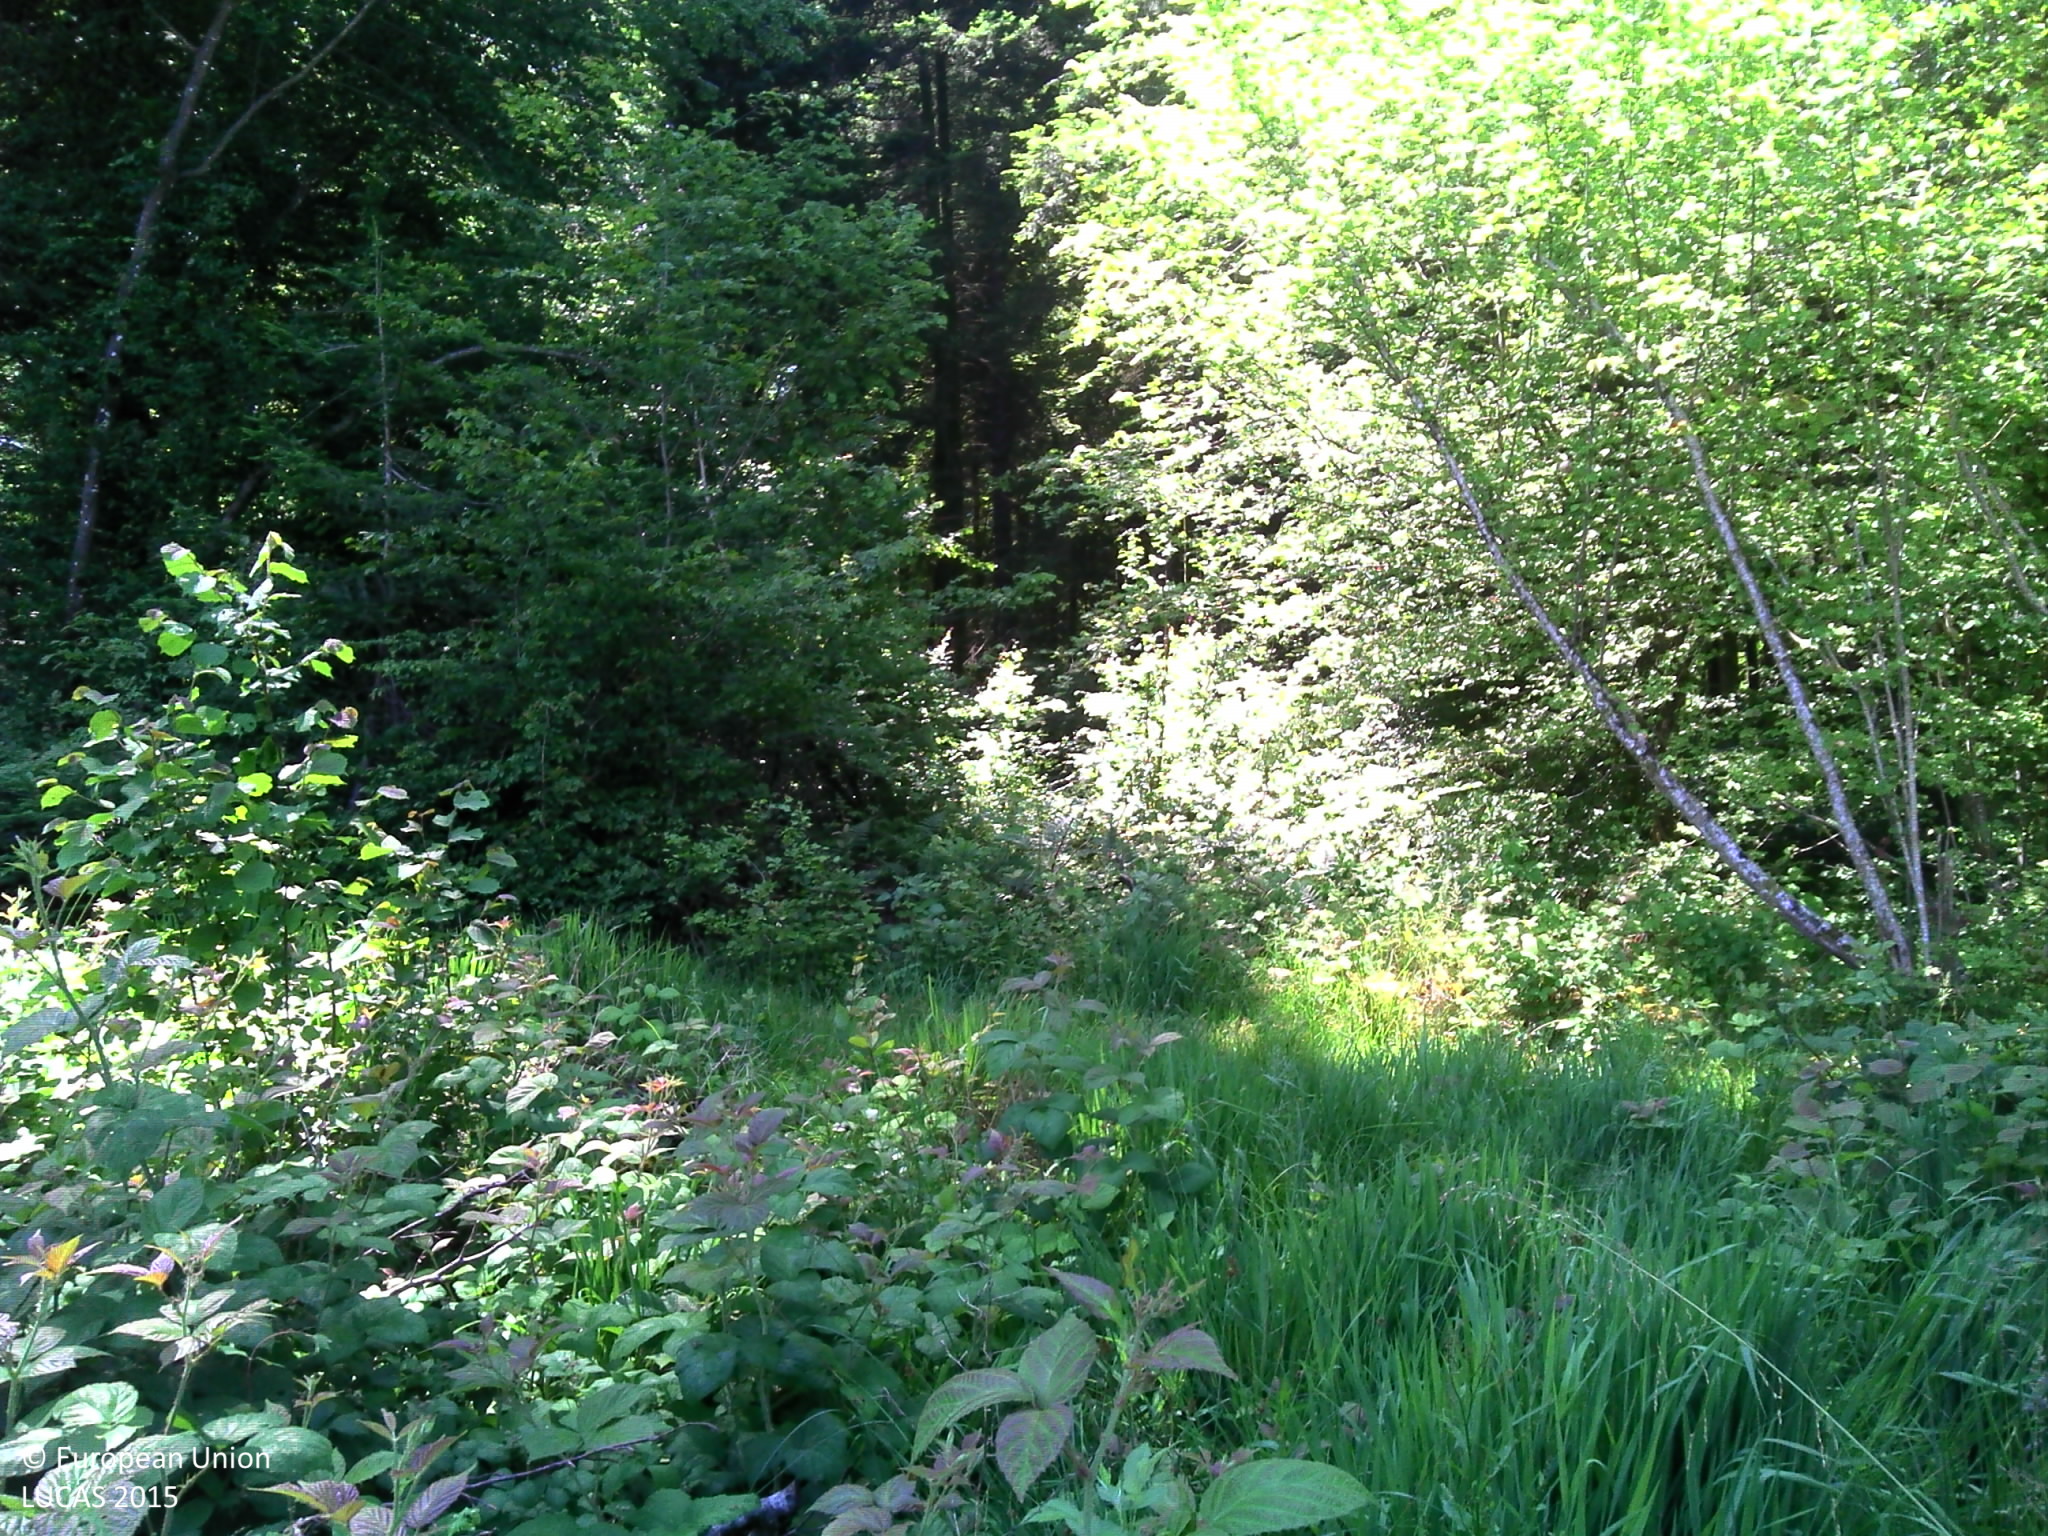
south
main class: Woodland
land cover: Broadleaved woodland
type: mesophytic deciduous forest
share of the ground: > 75 %
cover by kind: broadleaved forest trees 55 %, shrubs 20 %, herbaceous plants 15 %, coniferous forest trees 5 %, unconsolidated bare surface 5 %
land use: Forestry
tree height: < 5 m
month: June
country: FR
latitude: 47.5933
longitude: 6.0249
